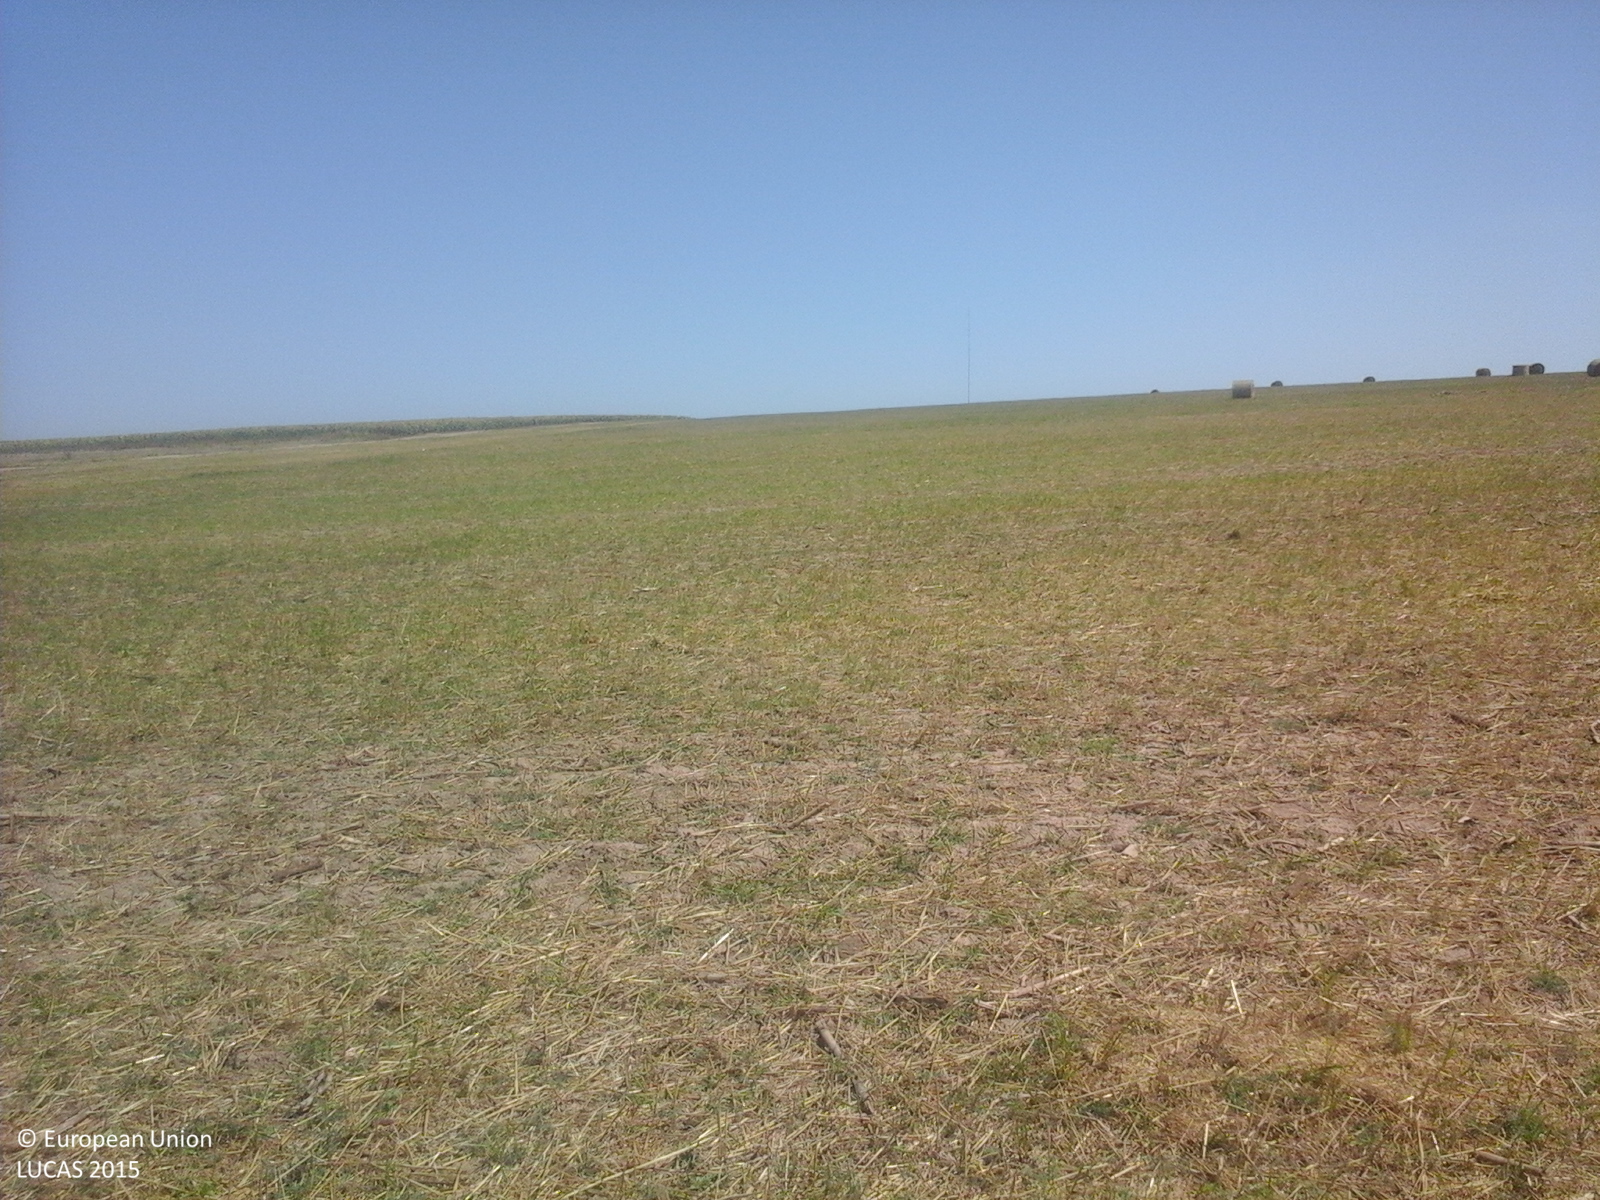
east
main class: Cropland
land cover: Common wheat
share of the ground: 10 - 25 %
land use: Agriculture (excluding fallow land and kitchen gardens)
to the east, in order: Common wheat; Tracks; Sunflower
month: August
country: RO
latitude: 44.4721
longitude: 28.1254
